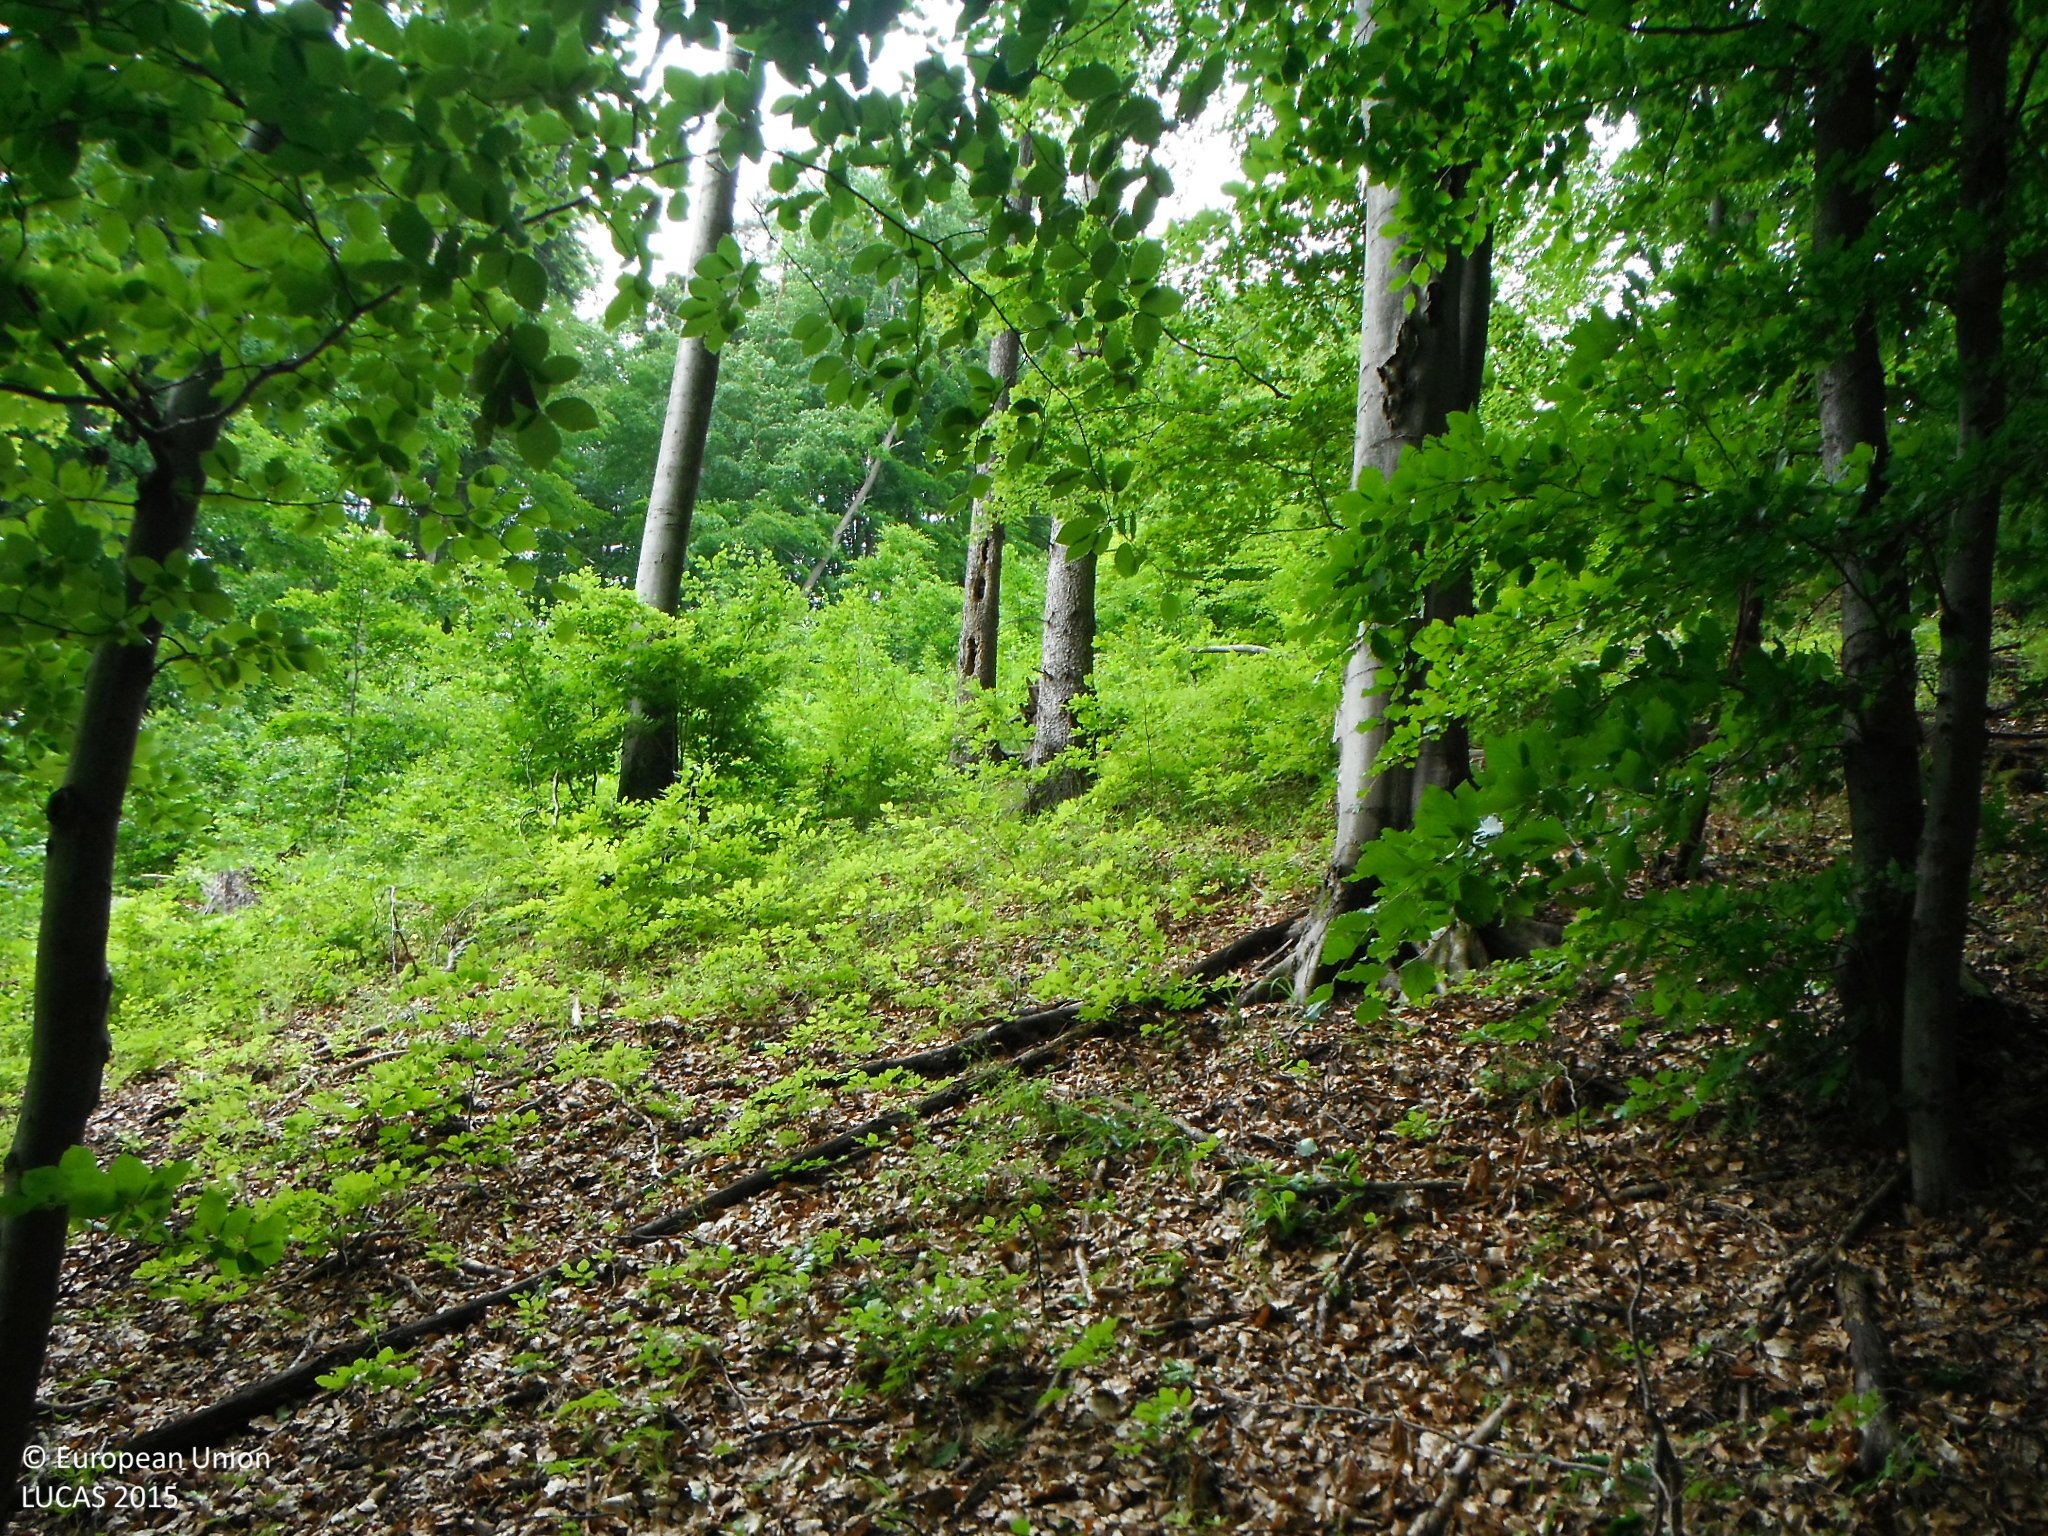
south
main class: Woodland
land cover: Other mixed woodland
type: mountainous beech forest
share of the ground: > 75 %
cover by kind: broadleaved forest trees 75 %, coniferous forest trees 25 %
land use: Forestry
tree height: > 5 m
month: May
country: SK
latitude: 48.4913
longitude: 18.9645
